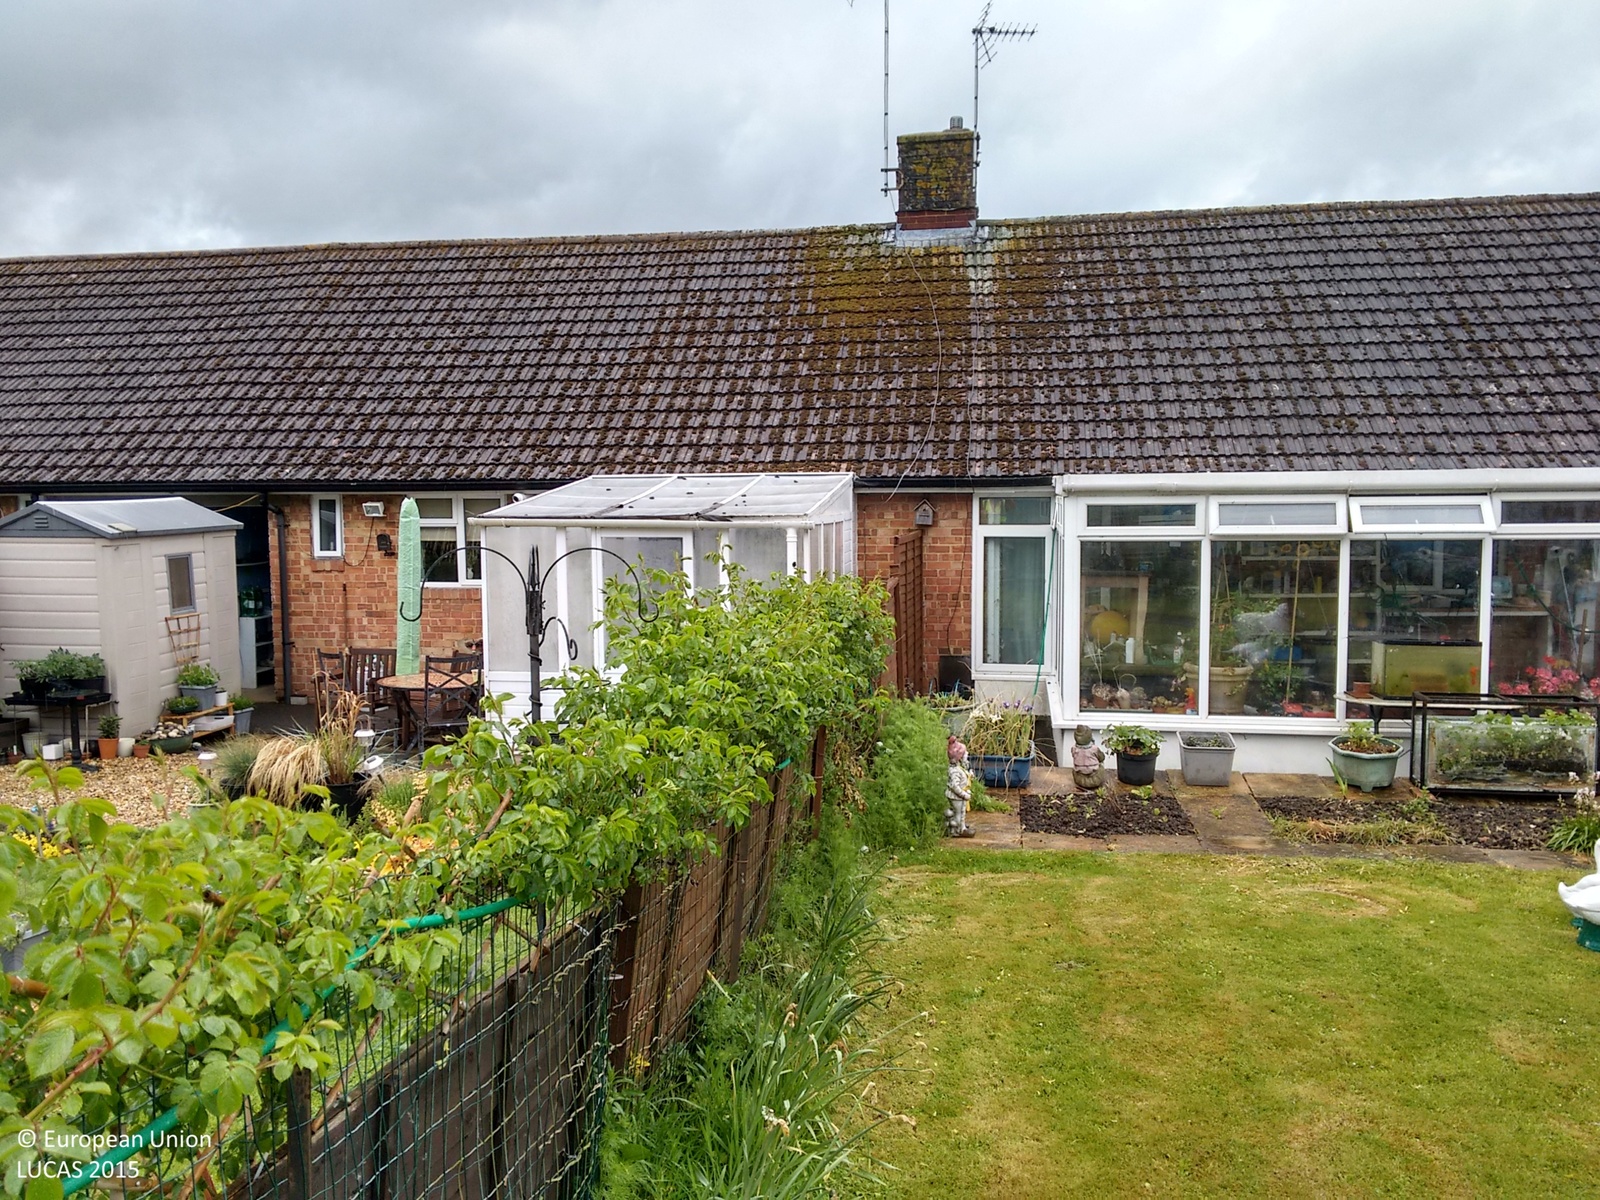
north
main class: Grassland
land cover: Grassland without tree/shrub cover
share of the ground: > 75 %
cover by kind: herbaceous plants 85 %, consolidated bare surface 10 %, shrubs 5 %
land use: Residential
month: May
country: GB
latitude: 50.9987
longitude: -0.9444
